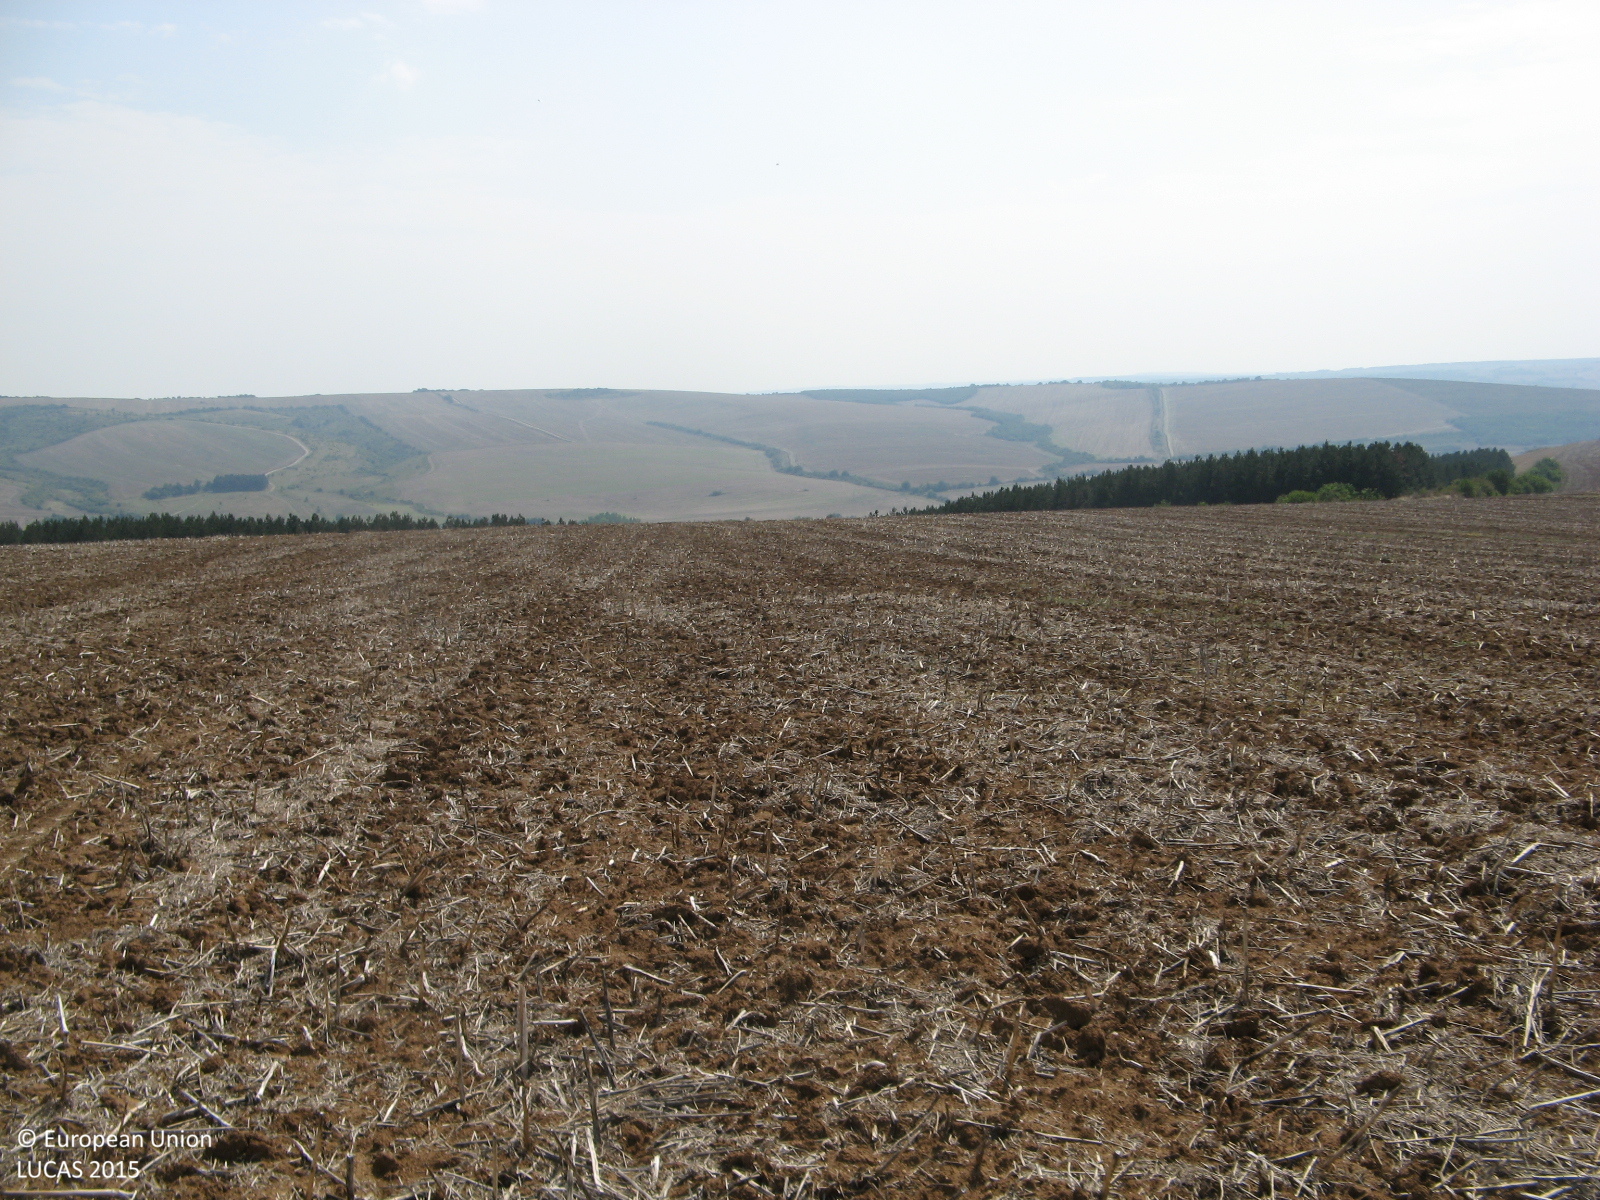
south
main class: Cropland
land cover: Rape and turnip rape
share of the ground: < 10 %
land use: Agriculture (excluding fallow land and kitchen gardens)
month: August
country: BG
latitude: 43.3976
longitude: 25.8549
